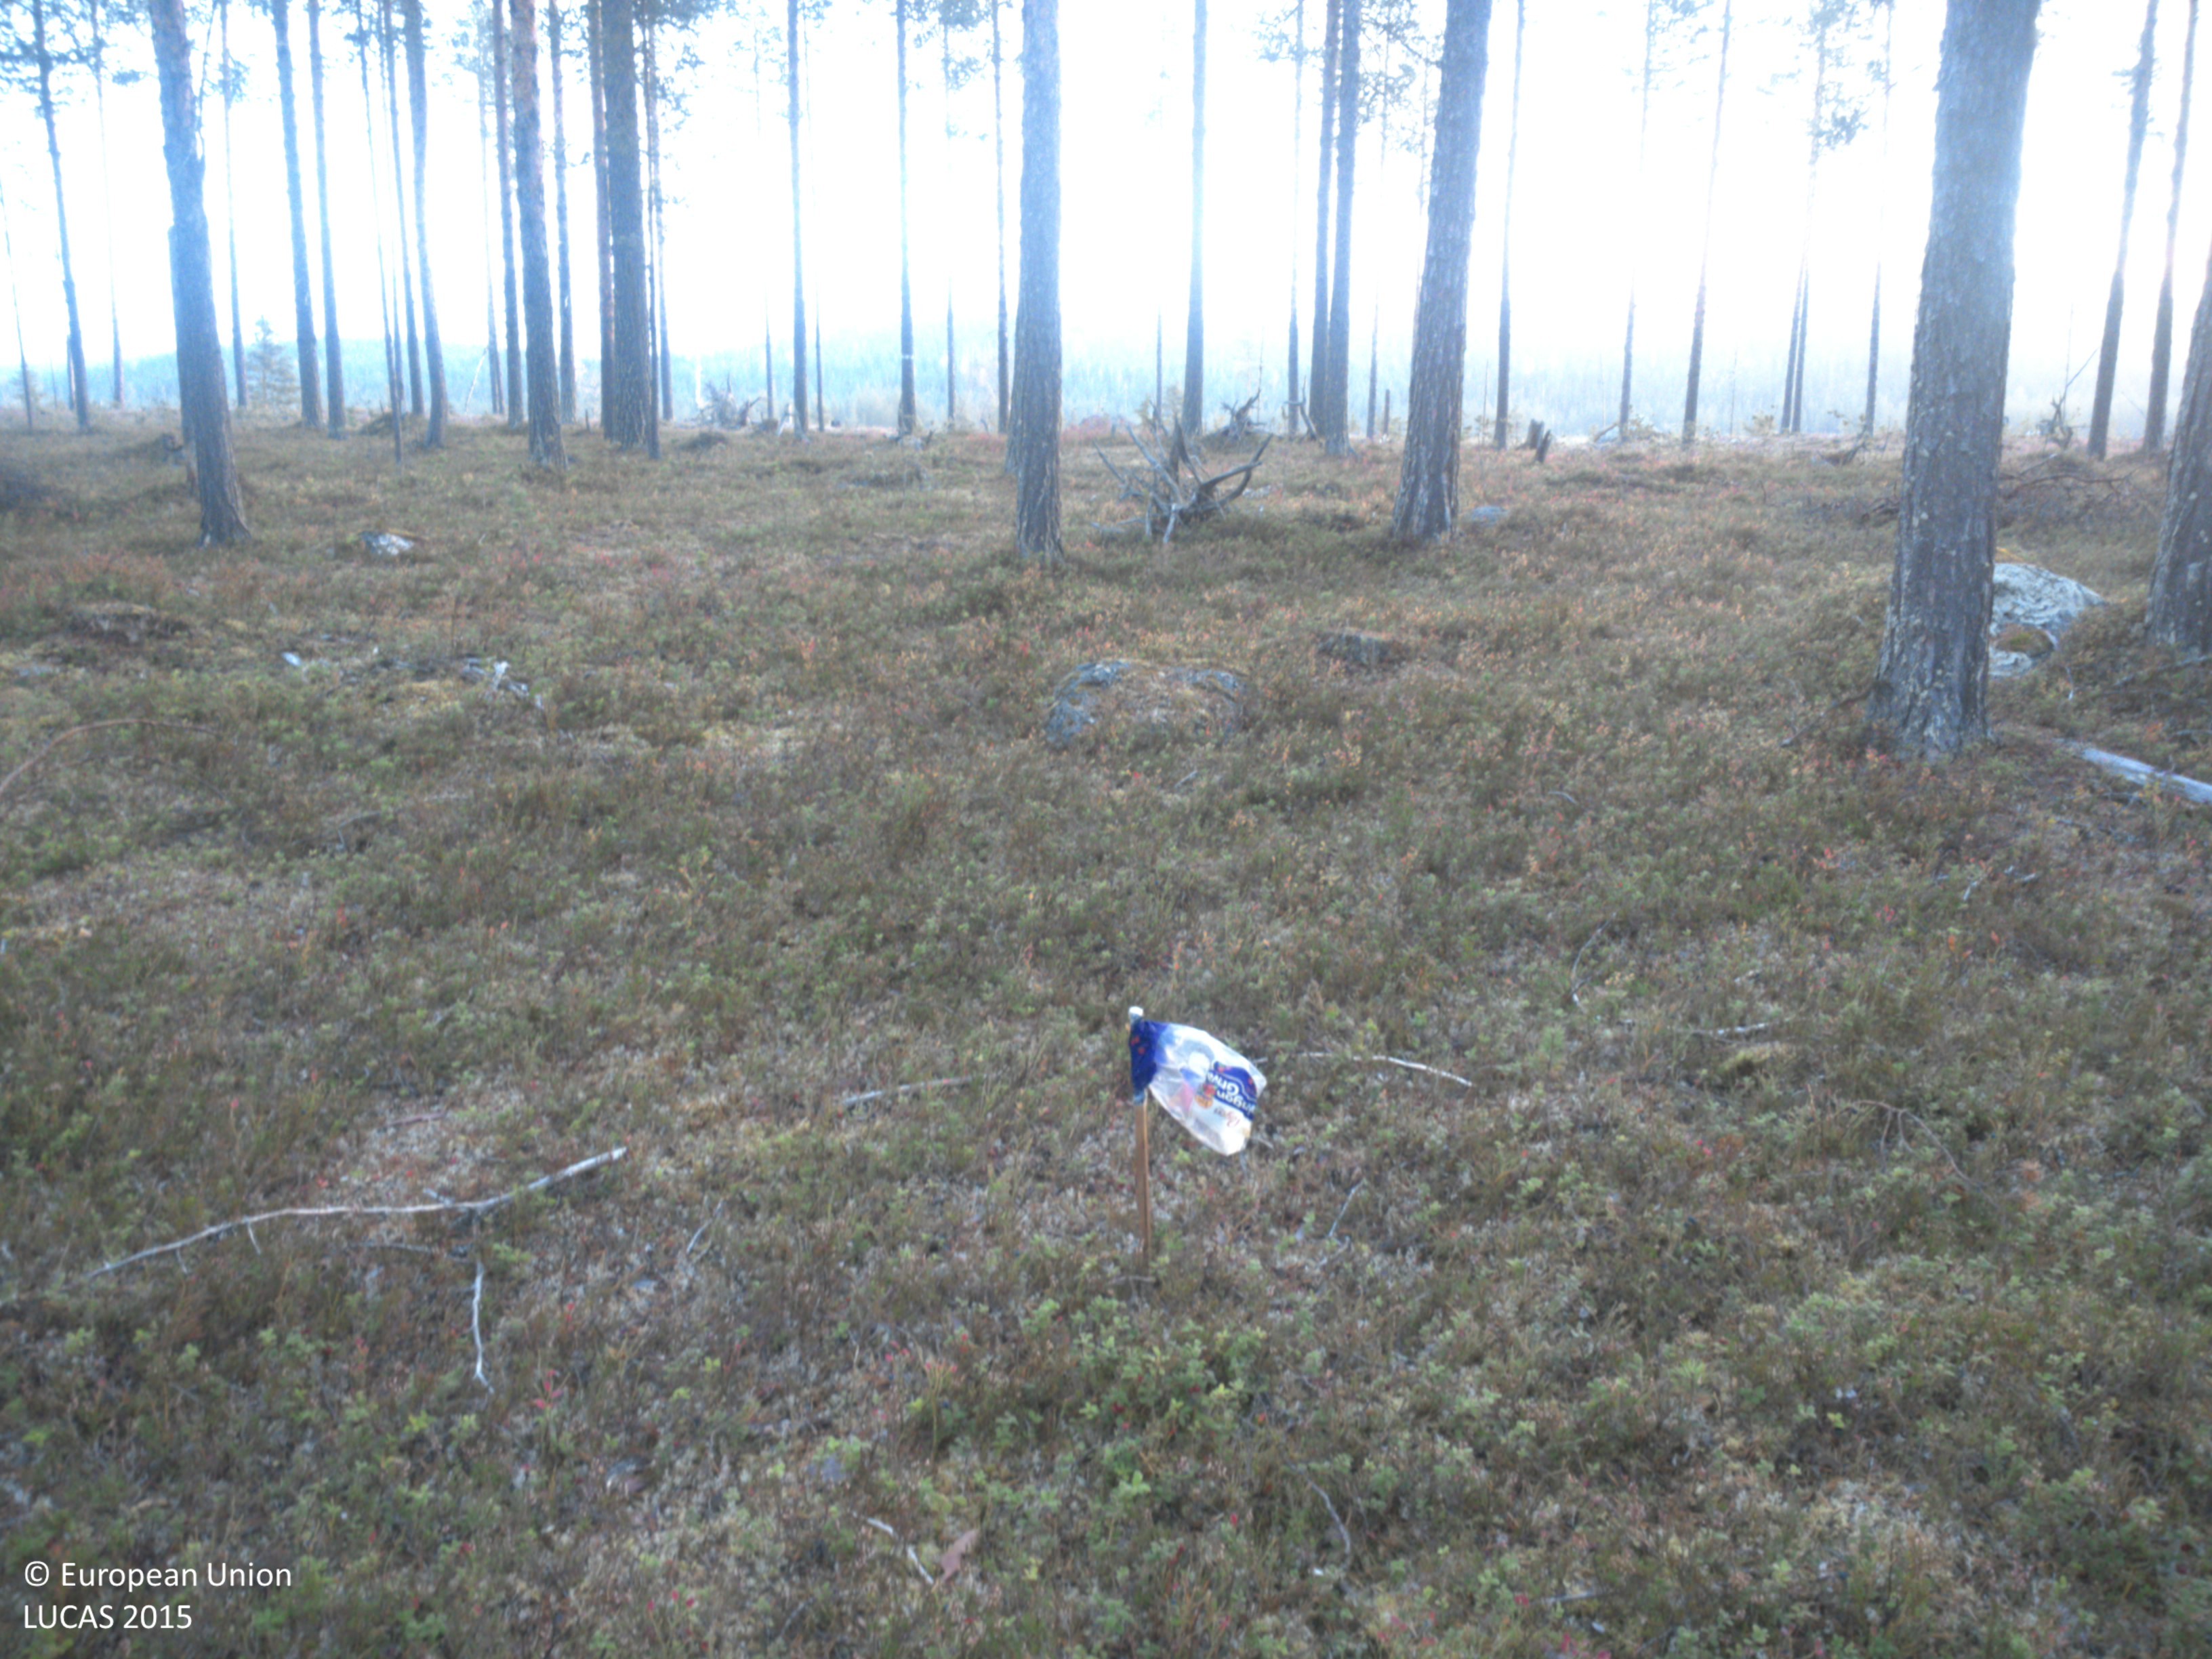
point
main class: Woodland
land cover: Pine dominated coniferous woodland
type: boreal forest
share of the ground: 25 - 50 %
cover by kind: coniferous forest trees 50 %, shrubs 25 %, lichens and mosses 15 %, herbaceous plants 10 %
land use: Forestry
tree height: > 5 m
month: October
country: SE
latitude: 64.7977
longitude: 18.3216
